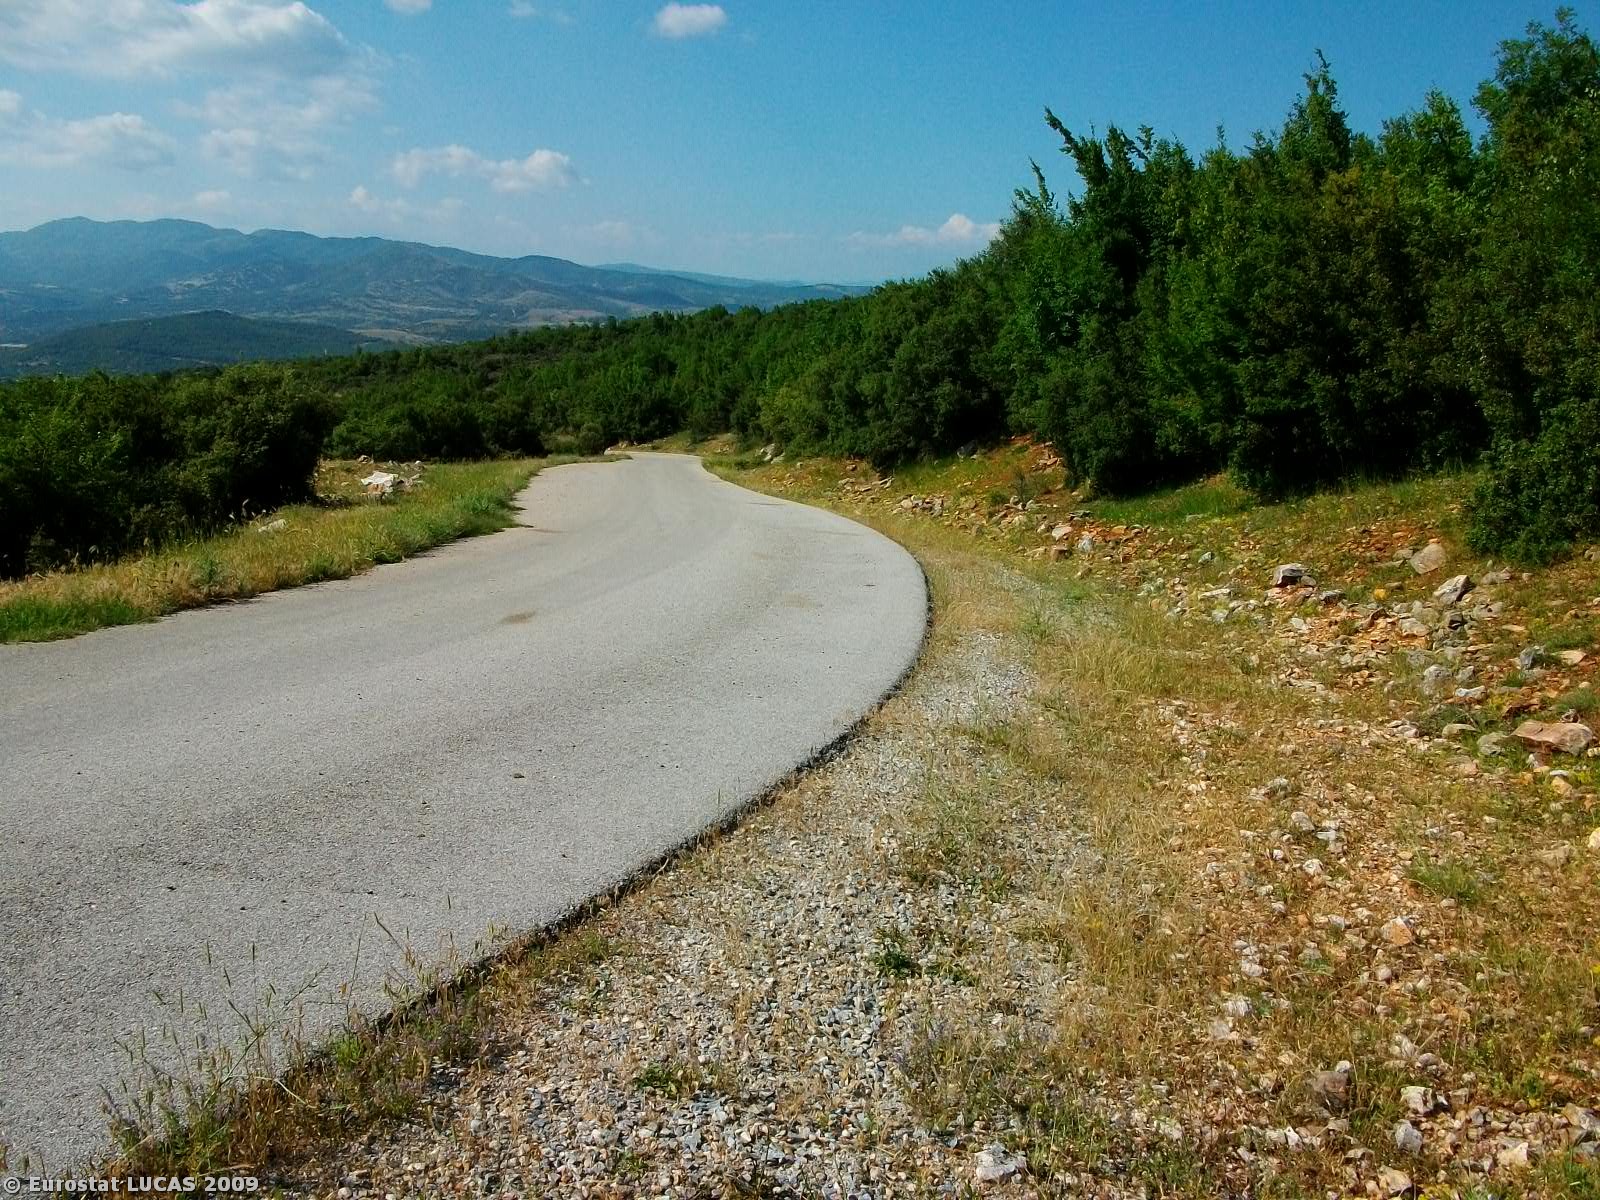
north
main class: Shrubland
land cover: Shrubland with sparse tree cover
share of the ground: > 75 %
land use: Unused
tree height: < 5 m
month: June
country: GR
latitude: 41.1760
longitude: 24.4218
